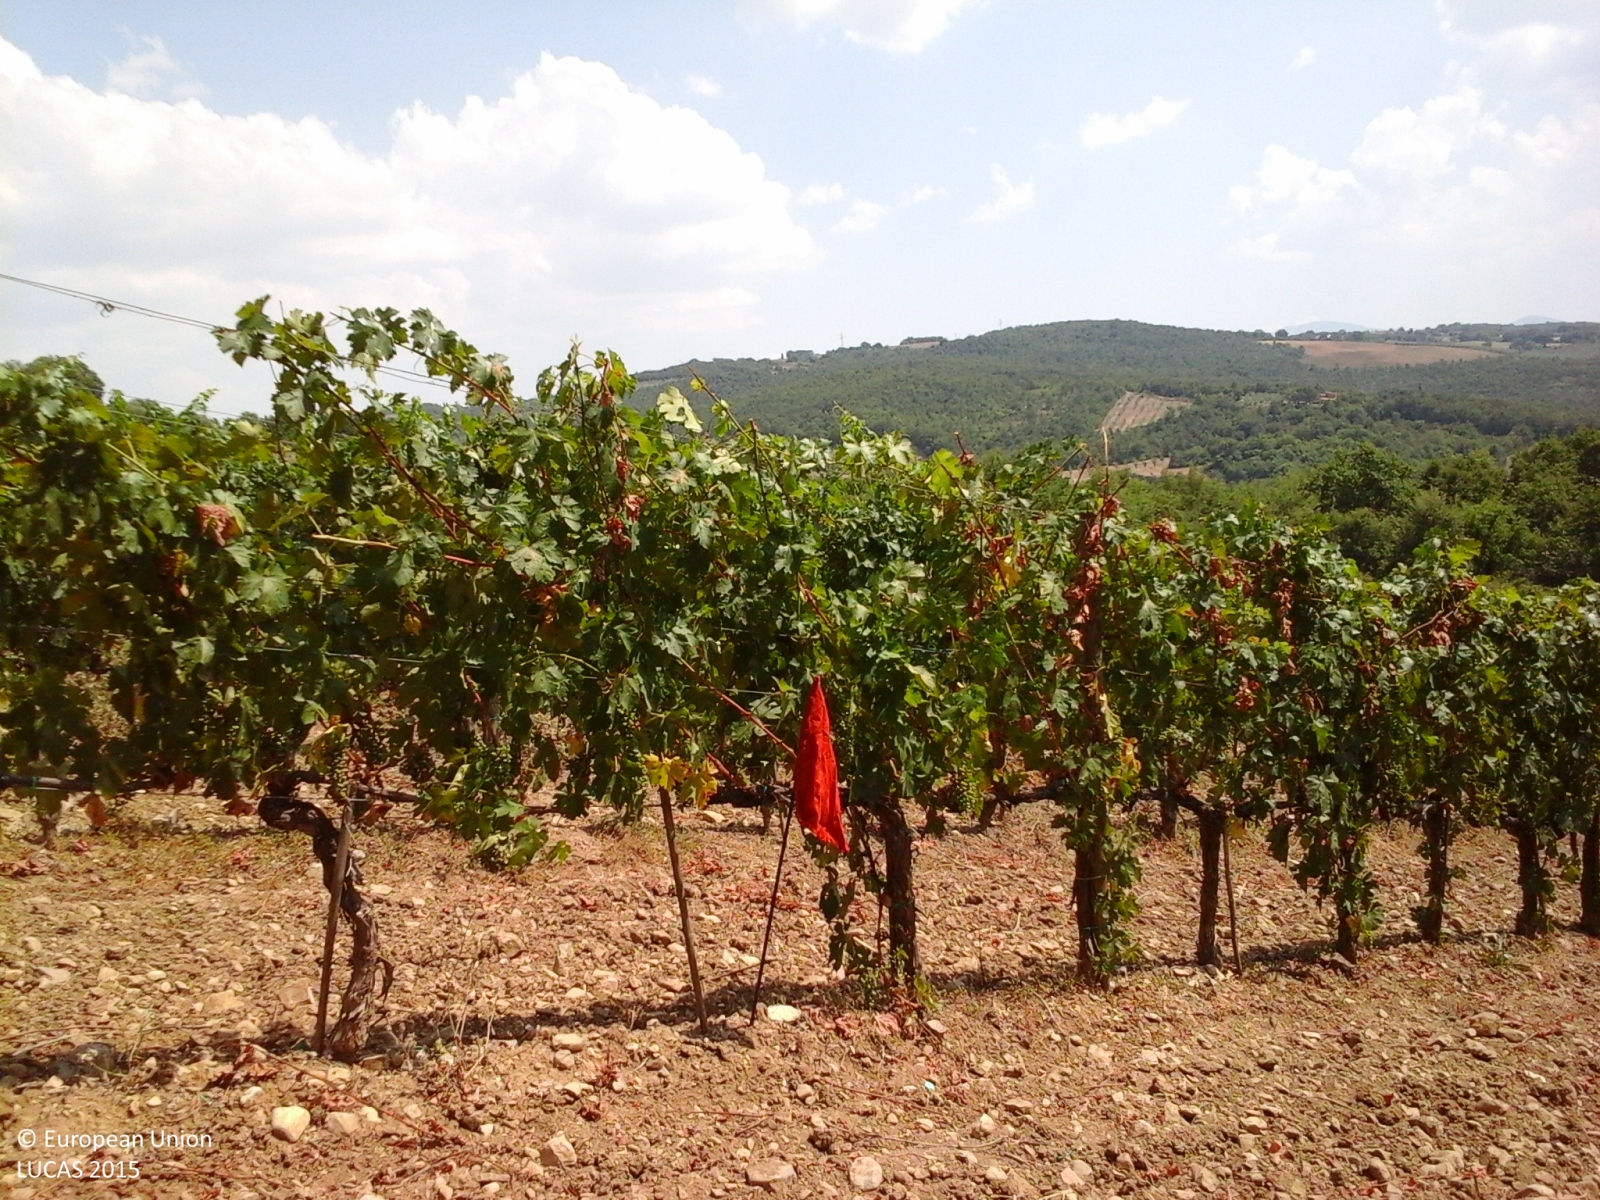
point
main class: Woodland
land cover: Broadleaved woodland
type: thermophilous deciduous forest
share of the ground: > 75 %
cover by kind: broadleaved forest trees 75 %, shrubs 20 %, herbaceous plants 5 %
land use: Forestry
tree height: > 5 m
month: July
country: IT
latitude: 43.0571
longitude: 11.5791
